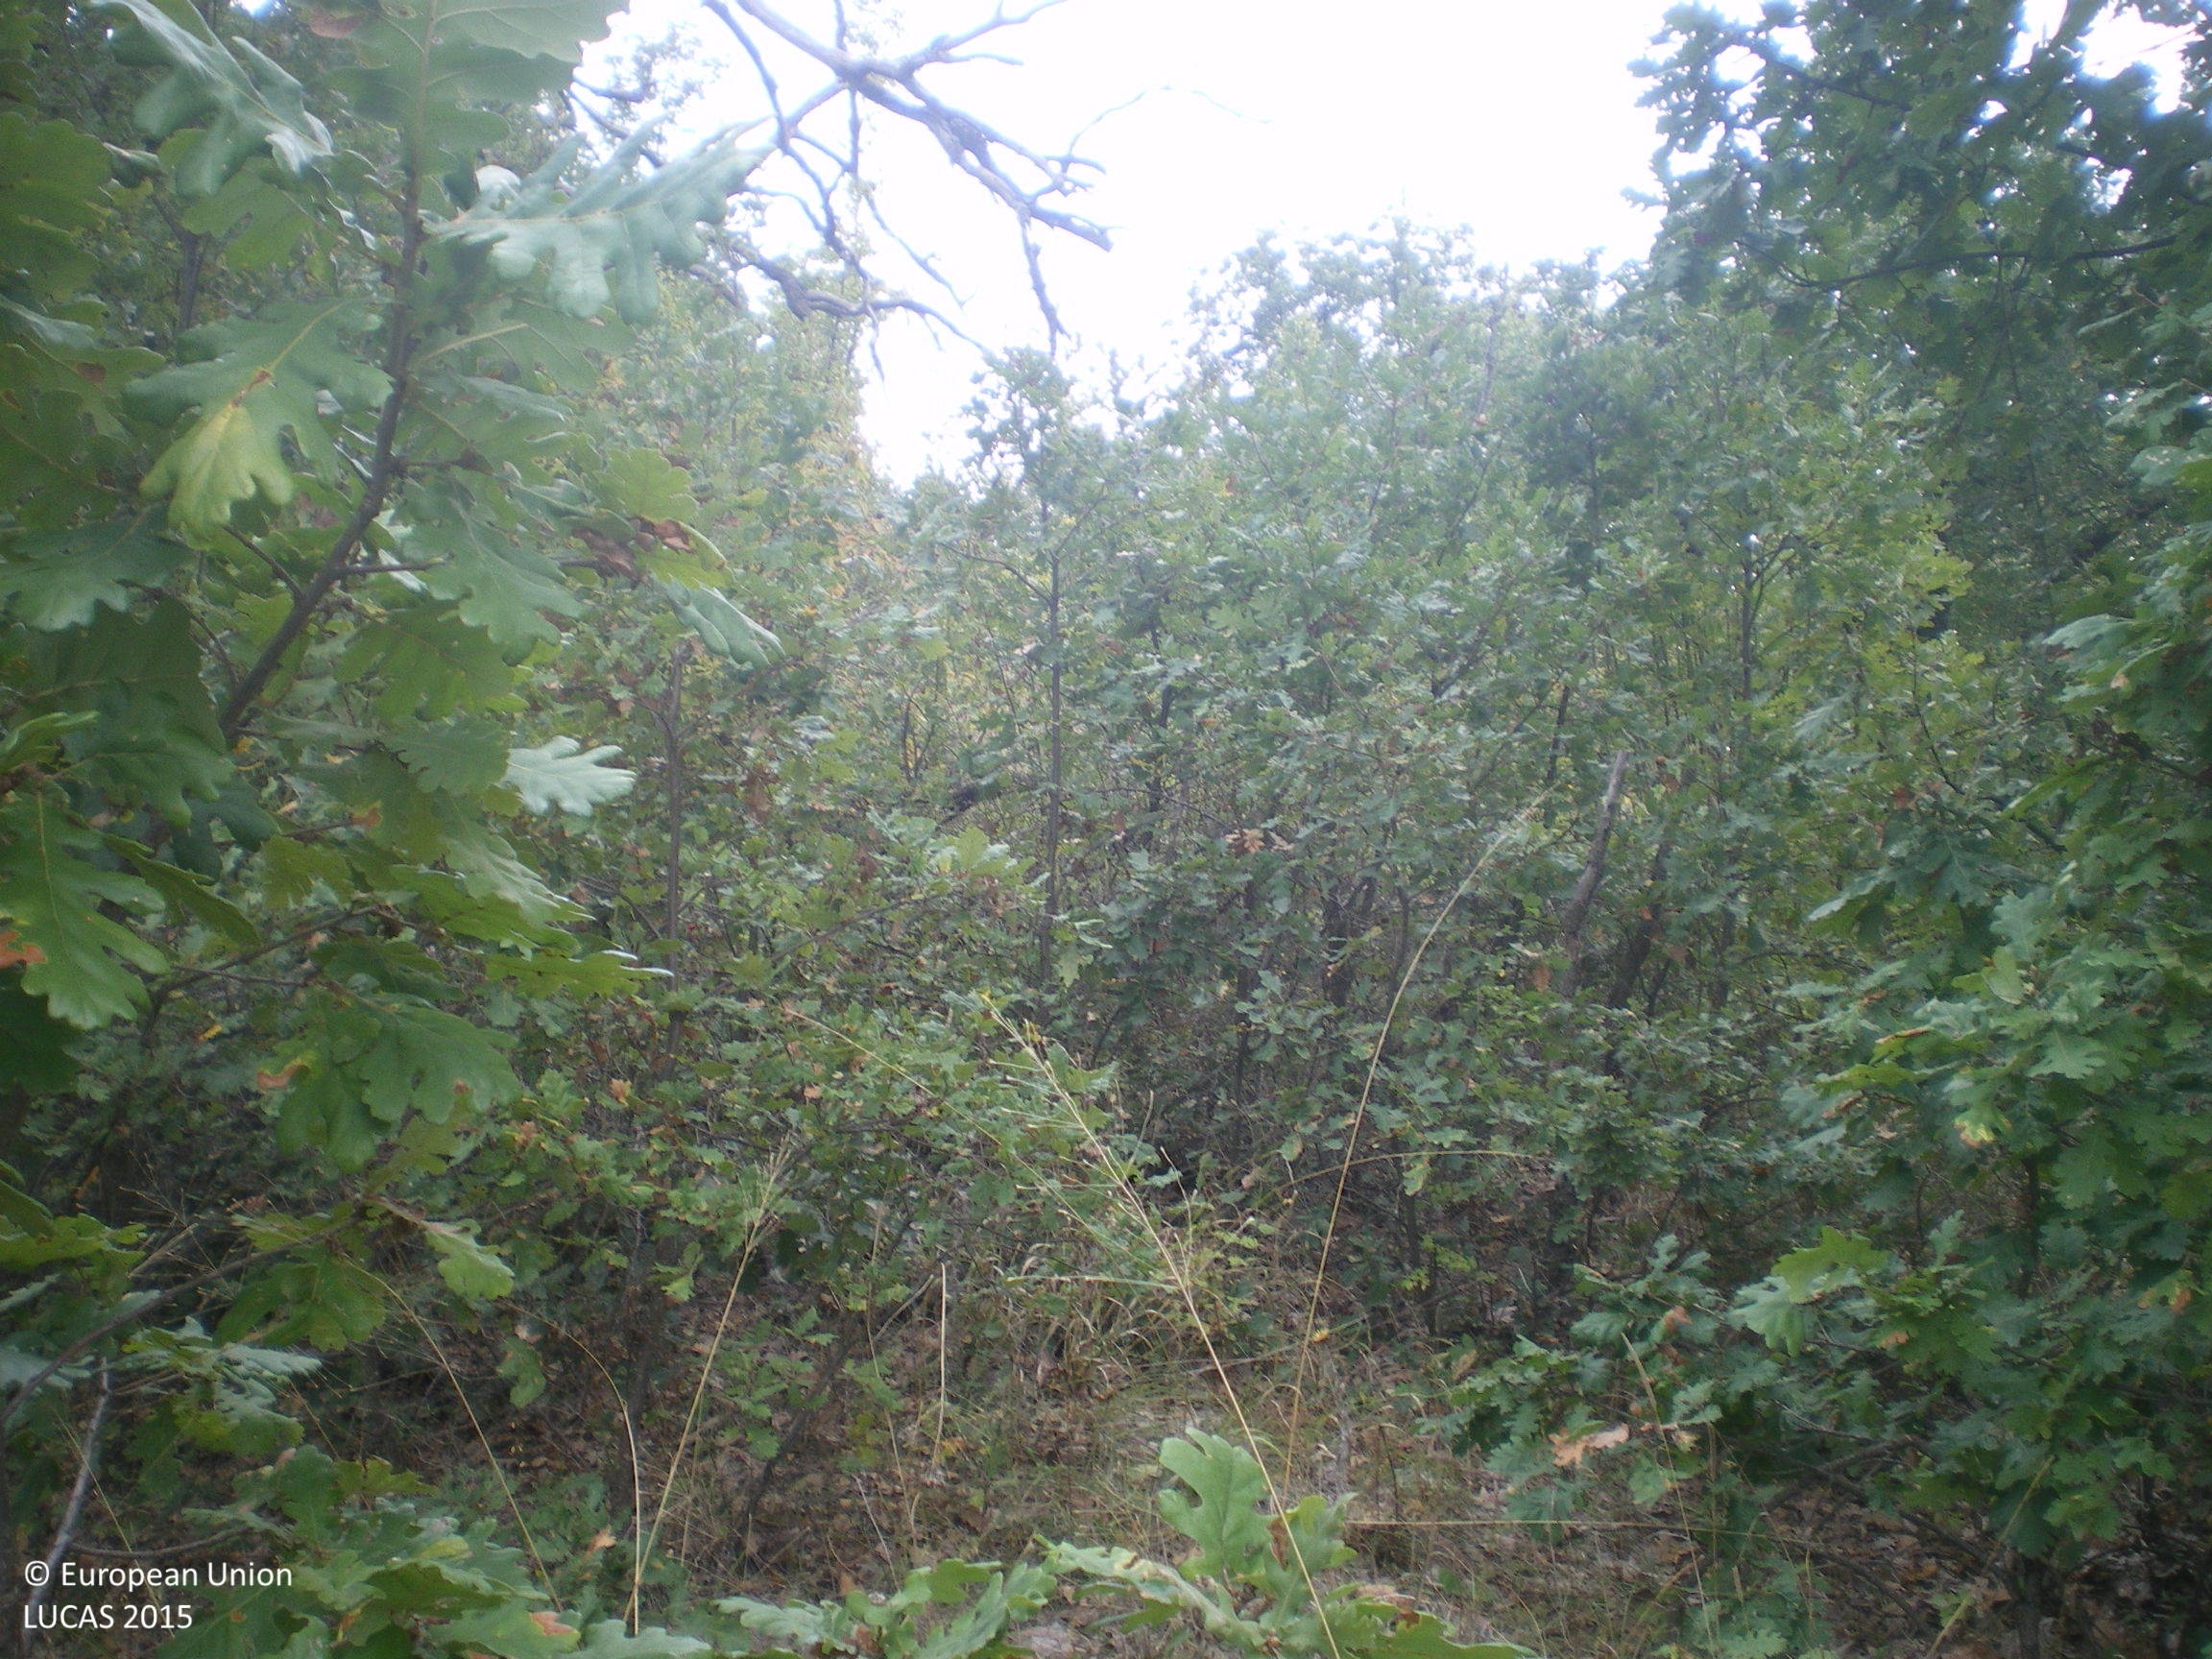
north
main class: Woodland
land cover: Broadleaved woodland
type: mesophytic deciduous forest
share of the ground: > 75 %
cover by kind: broadleaved forest trees 75 %, herbaceous plants 15 %, shrubs 10 %
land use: Forestry
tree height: > 5 m
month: October
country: BG
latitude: 41.9631
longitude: 26.2106
